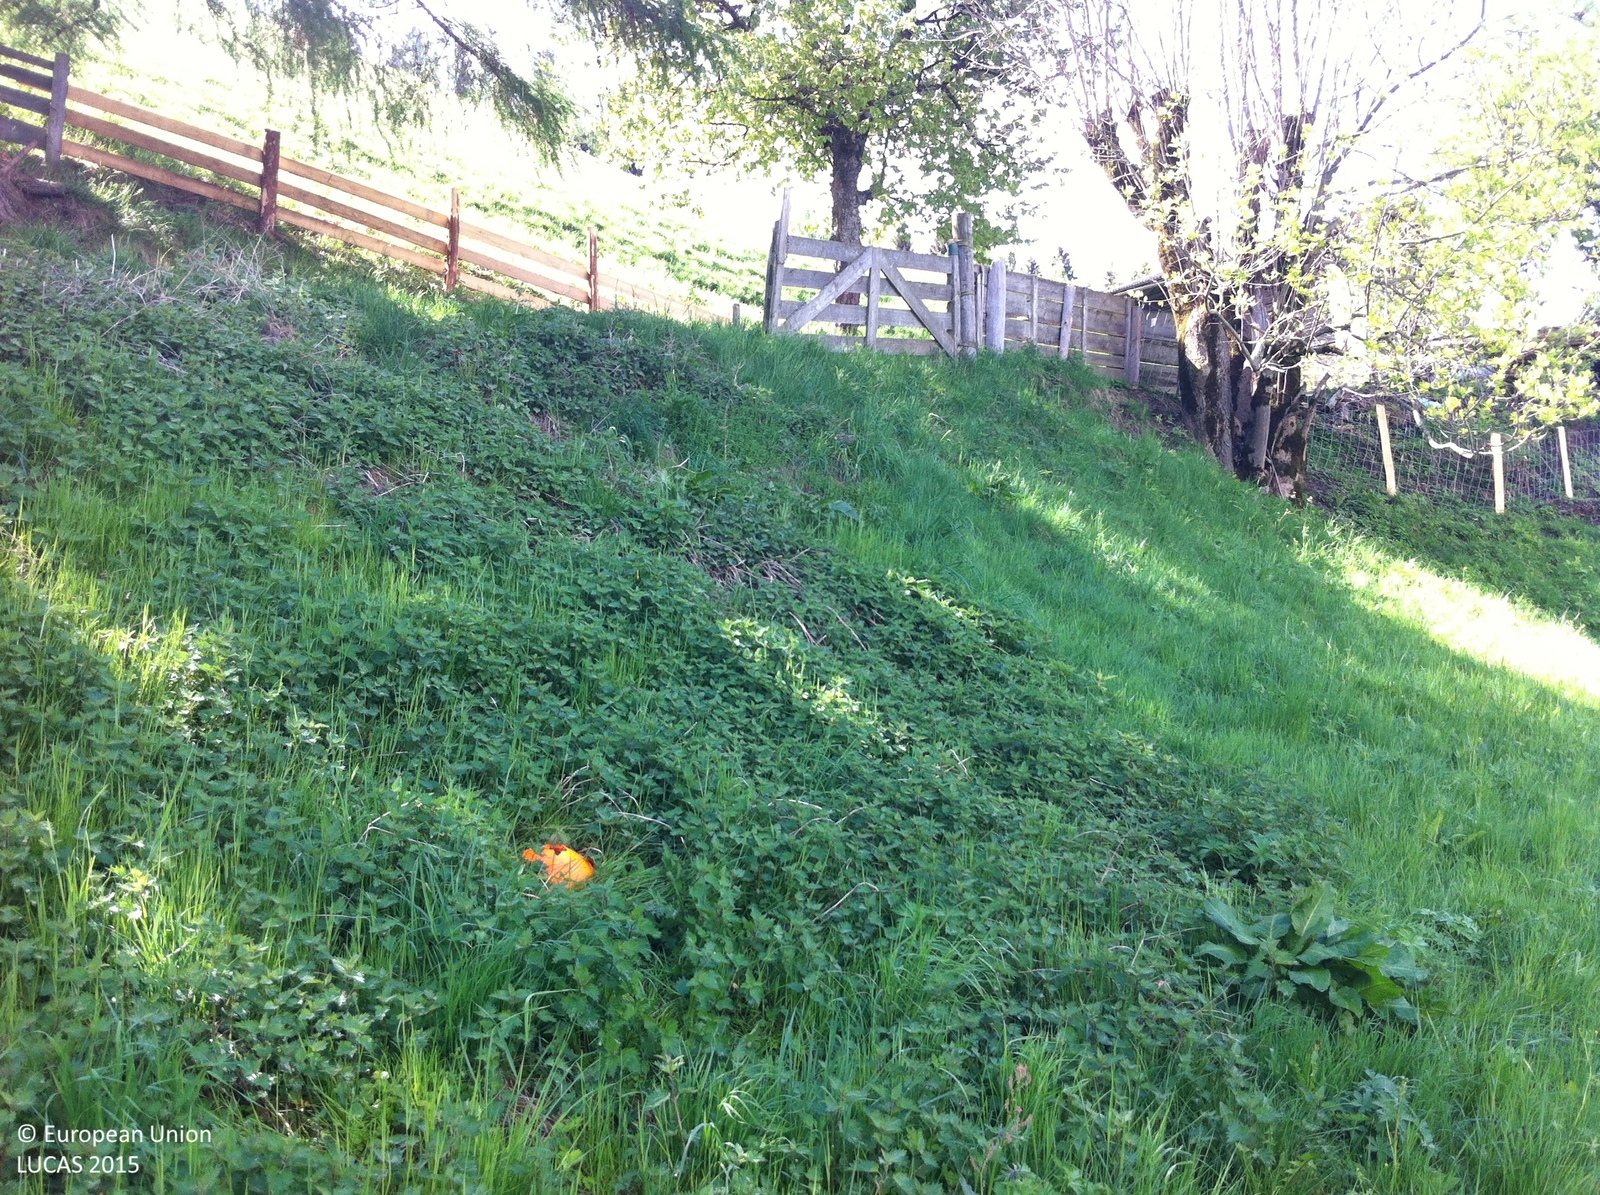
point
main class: Grassland
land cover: Grassland without tree/shrub cover
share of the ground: > 75 %
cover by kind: herbaceous plants 100 %
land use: Agriculture (excluding fallow land and kitchen gardens)
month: May
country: AT
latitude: 47.3458
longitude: 11.7325
